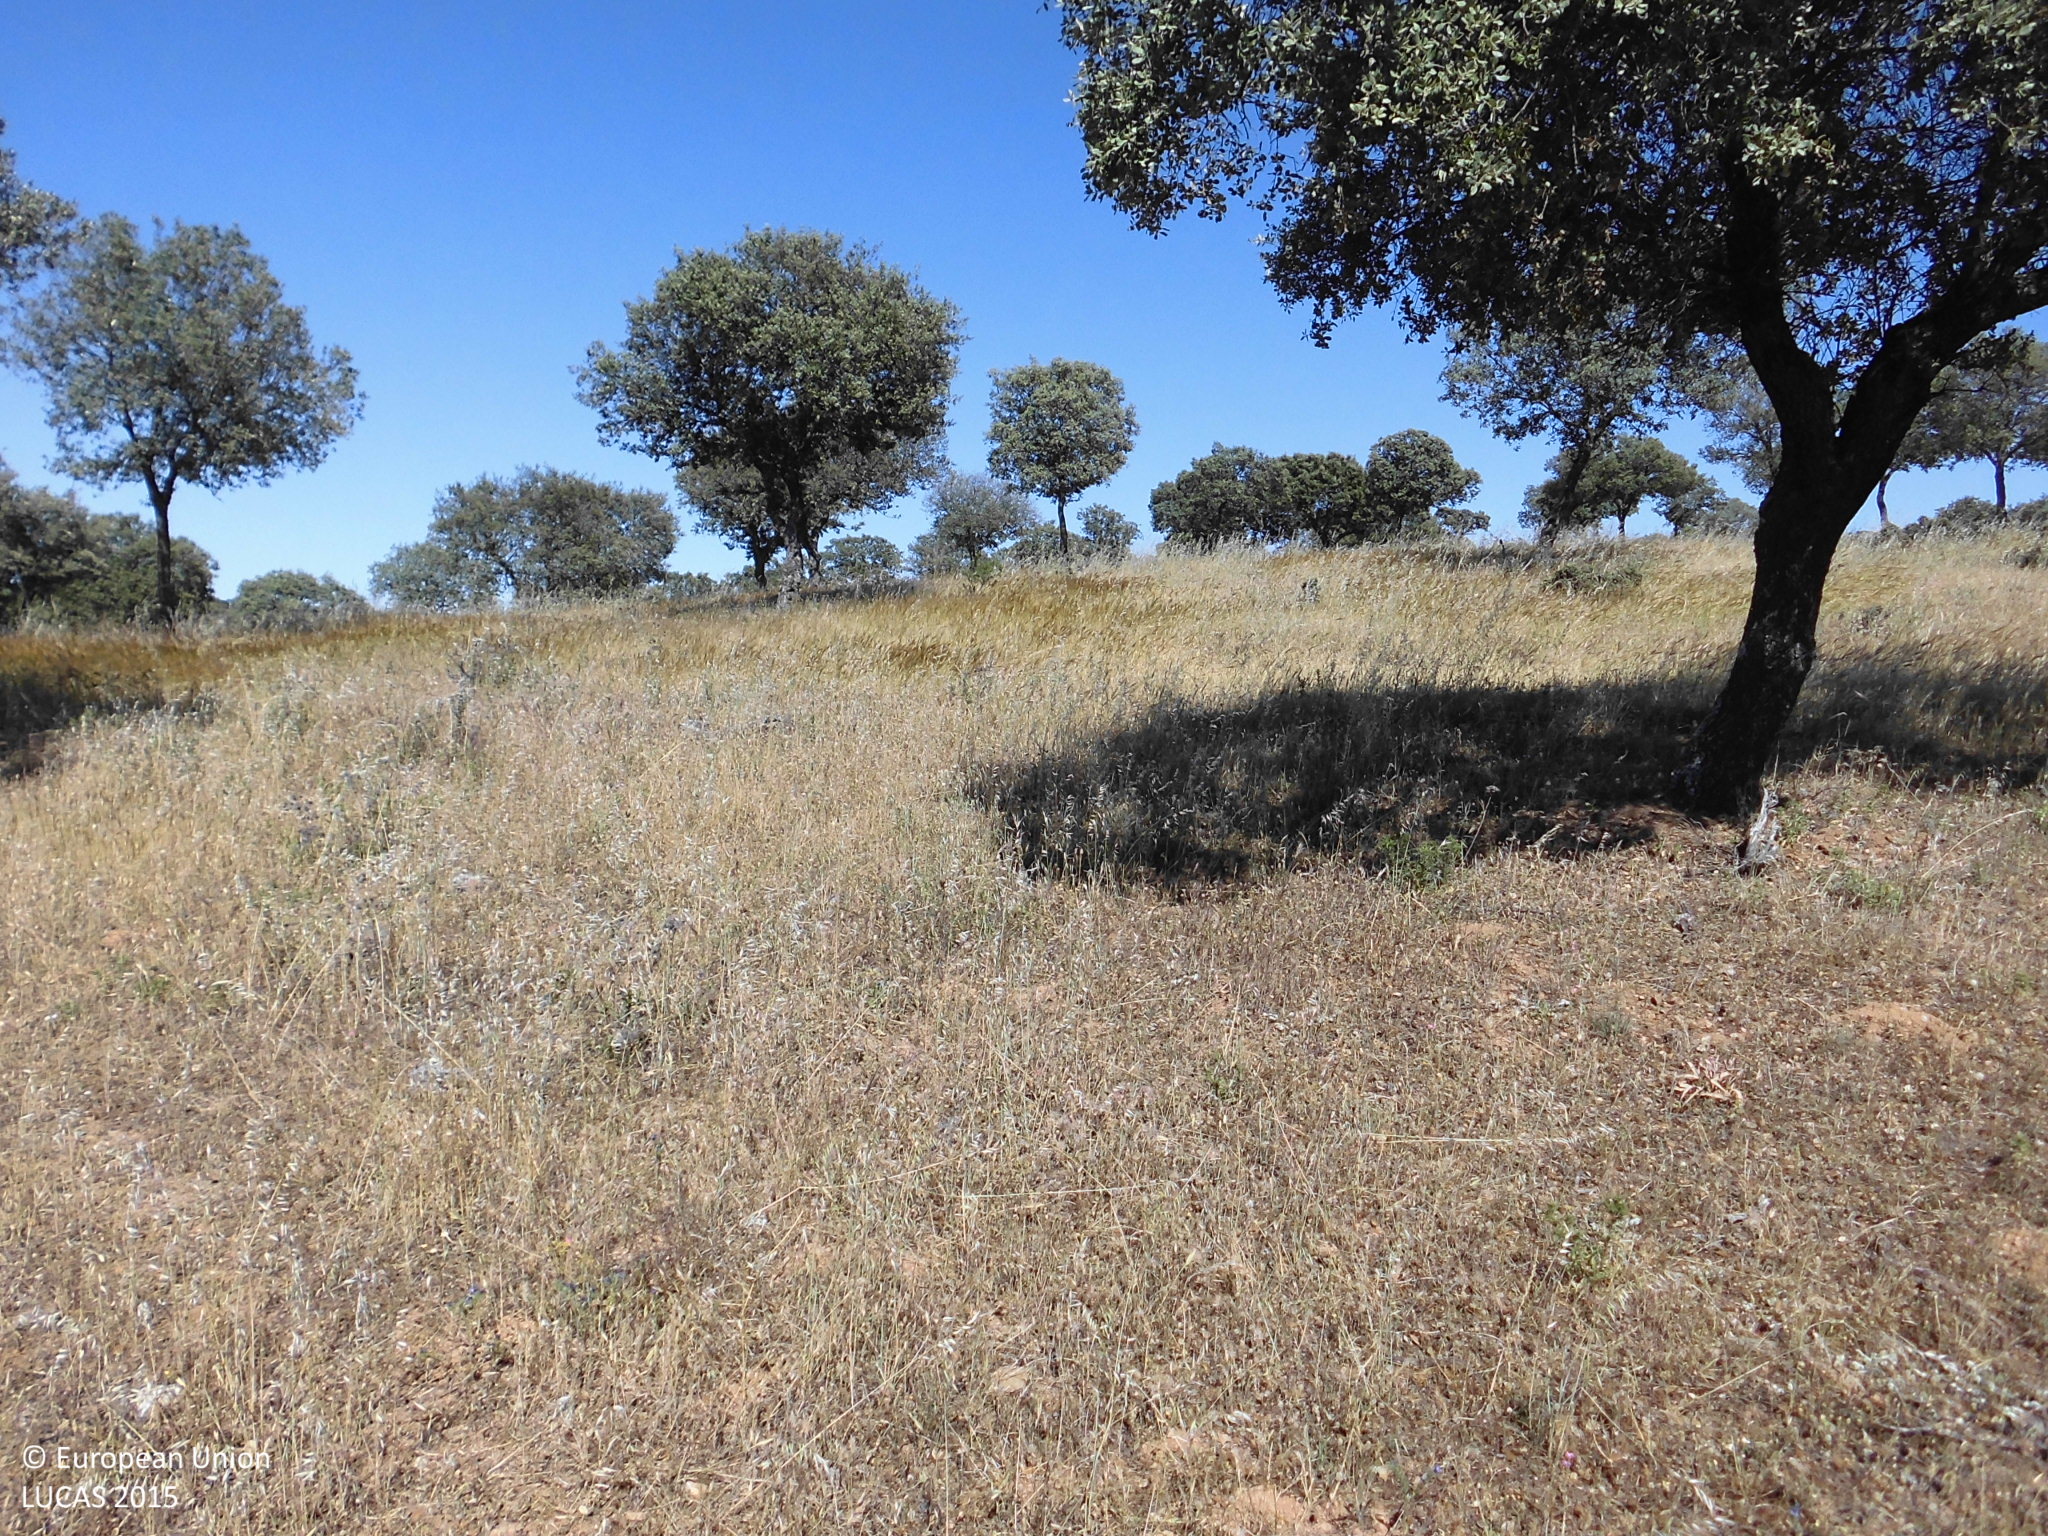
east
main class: Woodland
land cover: Broadleaved woodland
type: broadleaved evergreen forest
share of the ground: 10 - 25 %
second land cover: Grassland without tree/shrub cover
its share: > 75 %
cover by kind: herbaceous plants 85 %, broadleaved forest trees 15 %
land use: Forestry
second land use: Agriculture (excluding fallow land and kitchen gardens)
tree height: > 5 m
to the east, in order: Broadleaved woodland; Grassland without tree/shrub cover; Broadleaved woodland
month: May
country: ES
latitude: 39.4443
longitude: -6.8445
